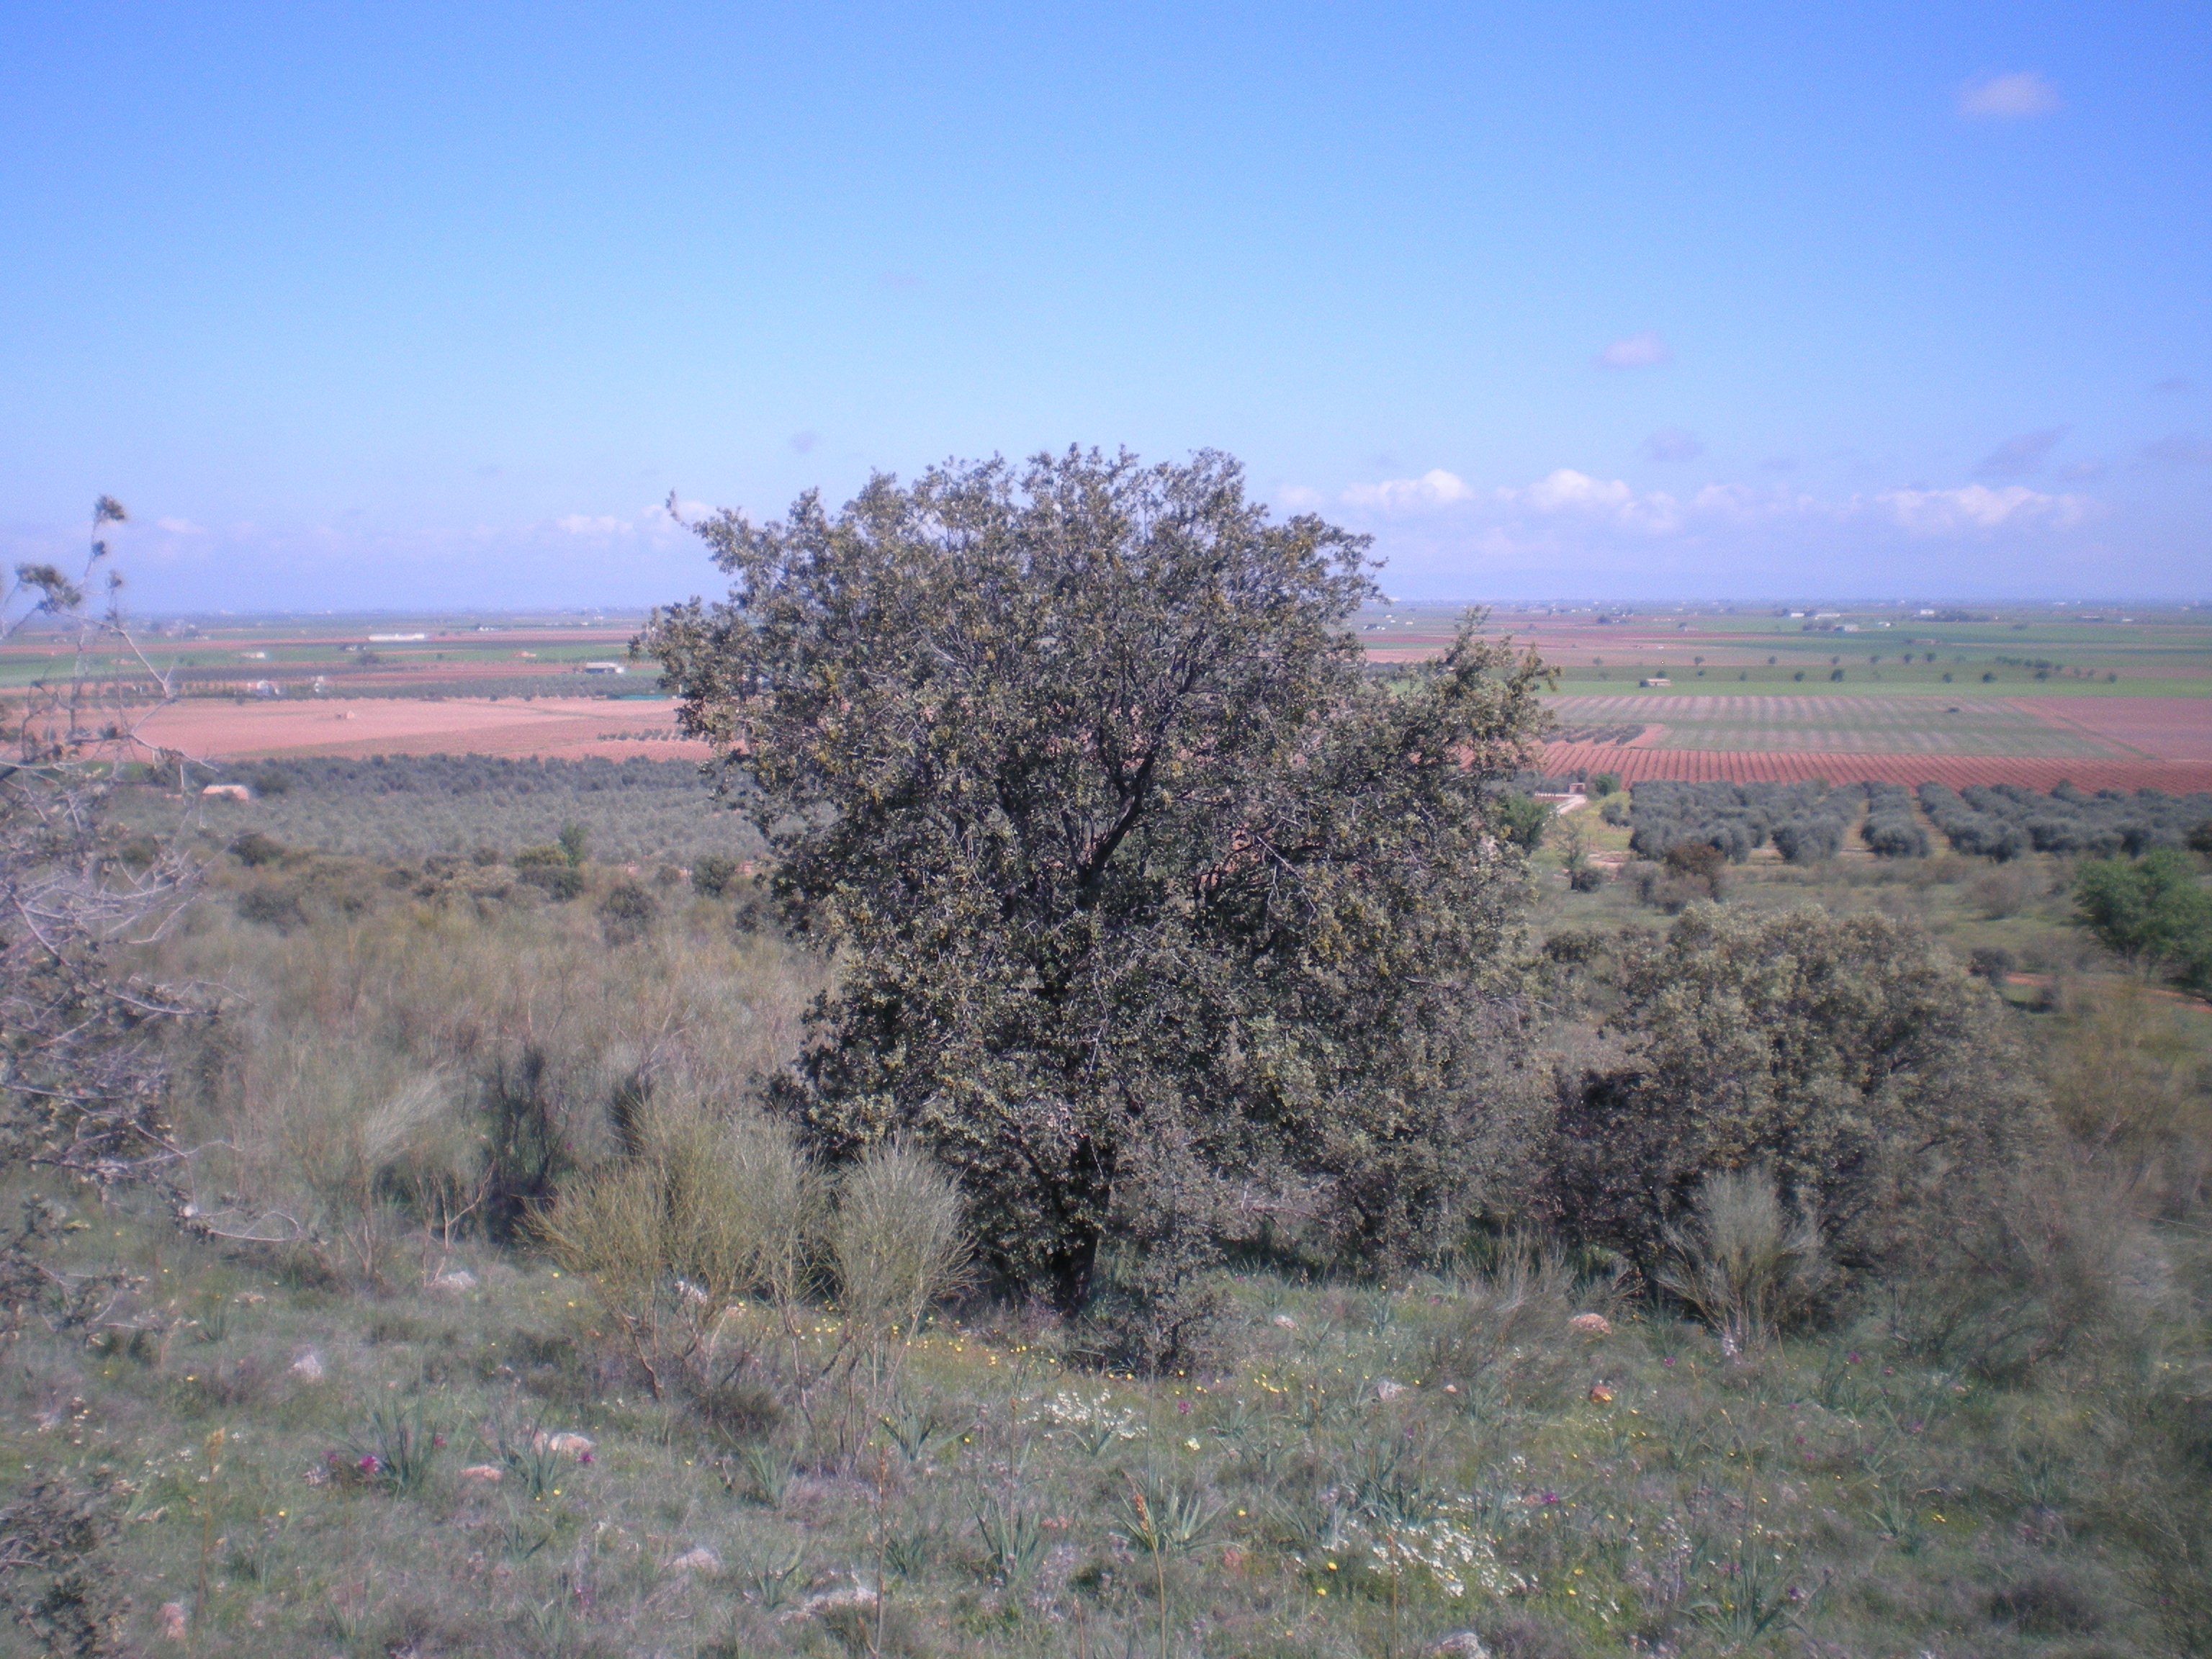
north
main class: Shrubland
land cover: Shrubland with sparse tree cover
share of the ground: 10 - 25 %
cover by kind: herbaceous plants 75 %, shrubs 20 %, broadleaved forest trees 5 %
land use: Agriculture (excluding fallow land and kitchen gardens)
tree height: < 5 m
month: April
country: ES
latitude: 38.9202
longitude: -3.5441
